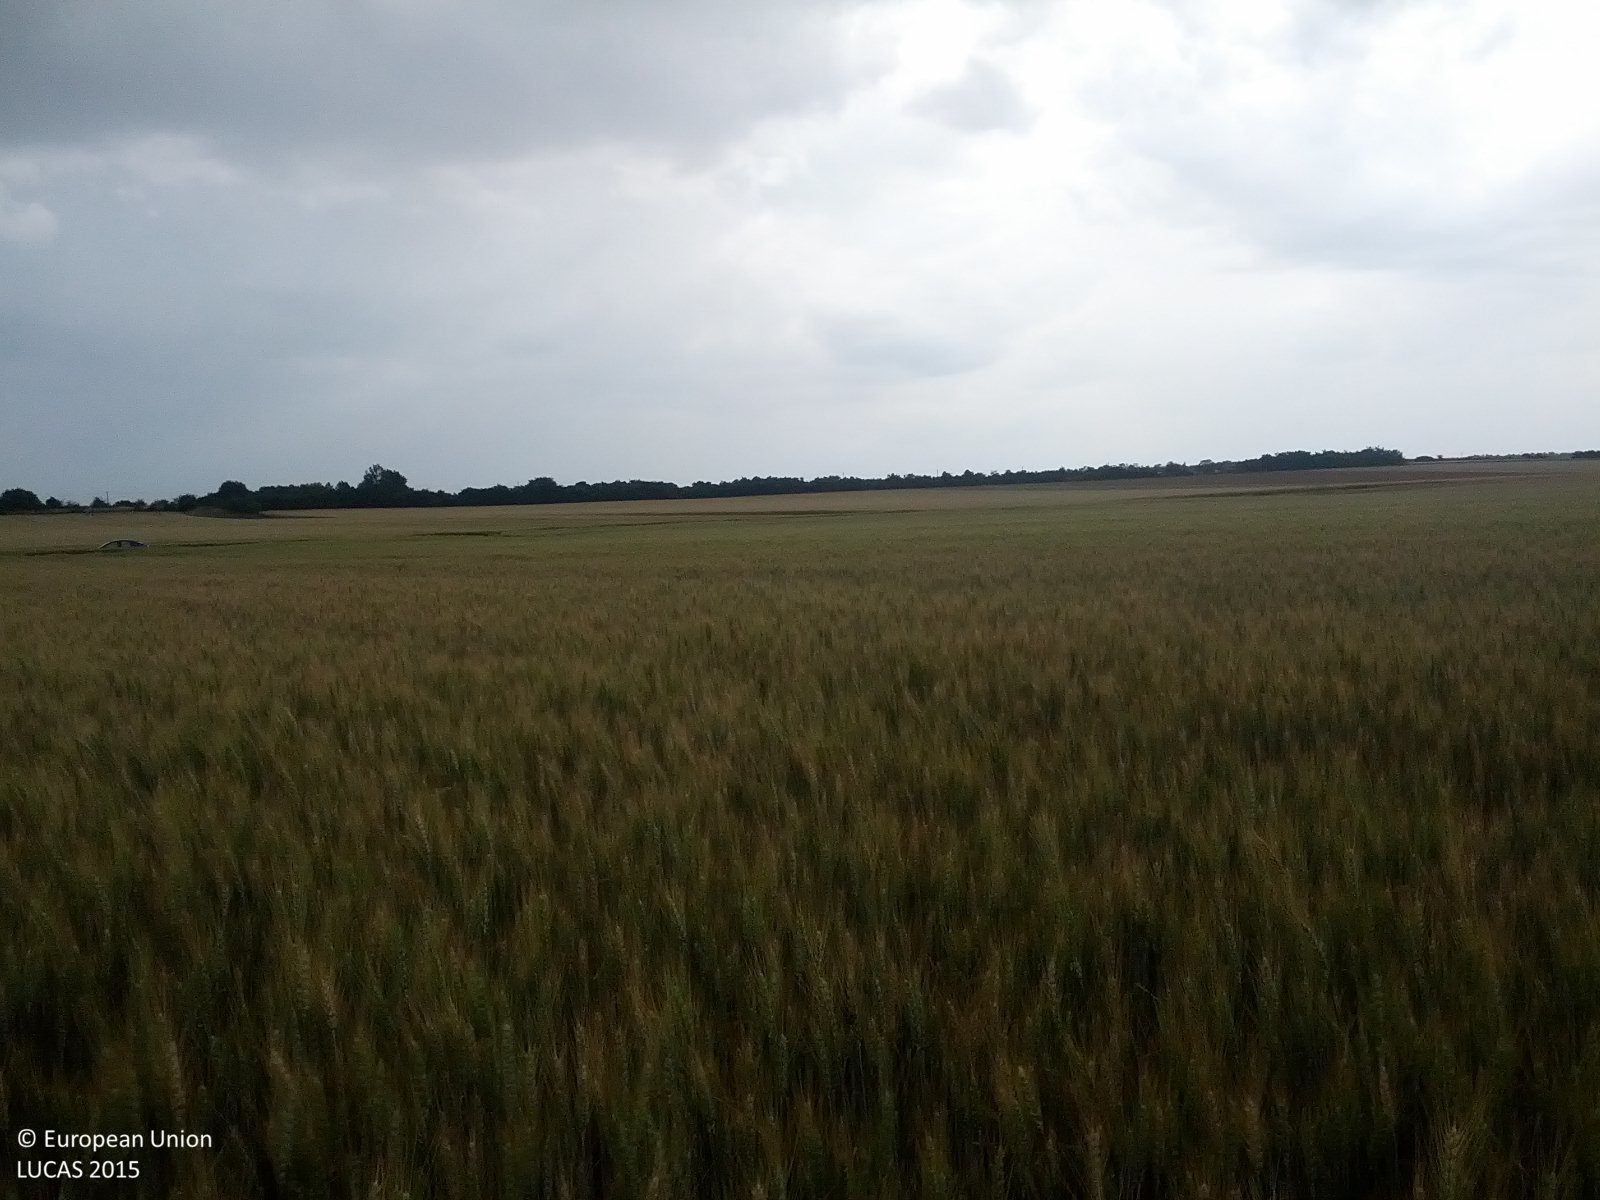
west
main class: Cropland
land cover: Common wheat
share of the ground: > 75 %
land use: Agriculture (excluding fallow land and kitchen gardens)
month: June
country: AT
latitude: 48.2803
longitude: 16.8662
